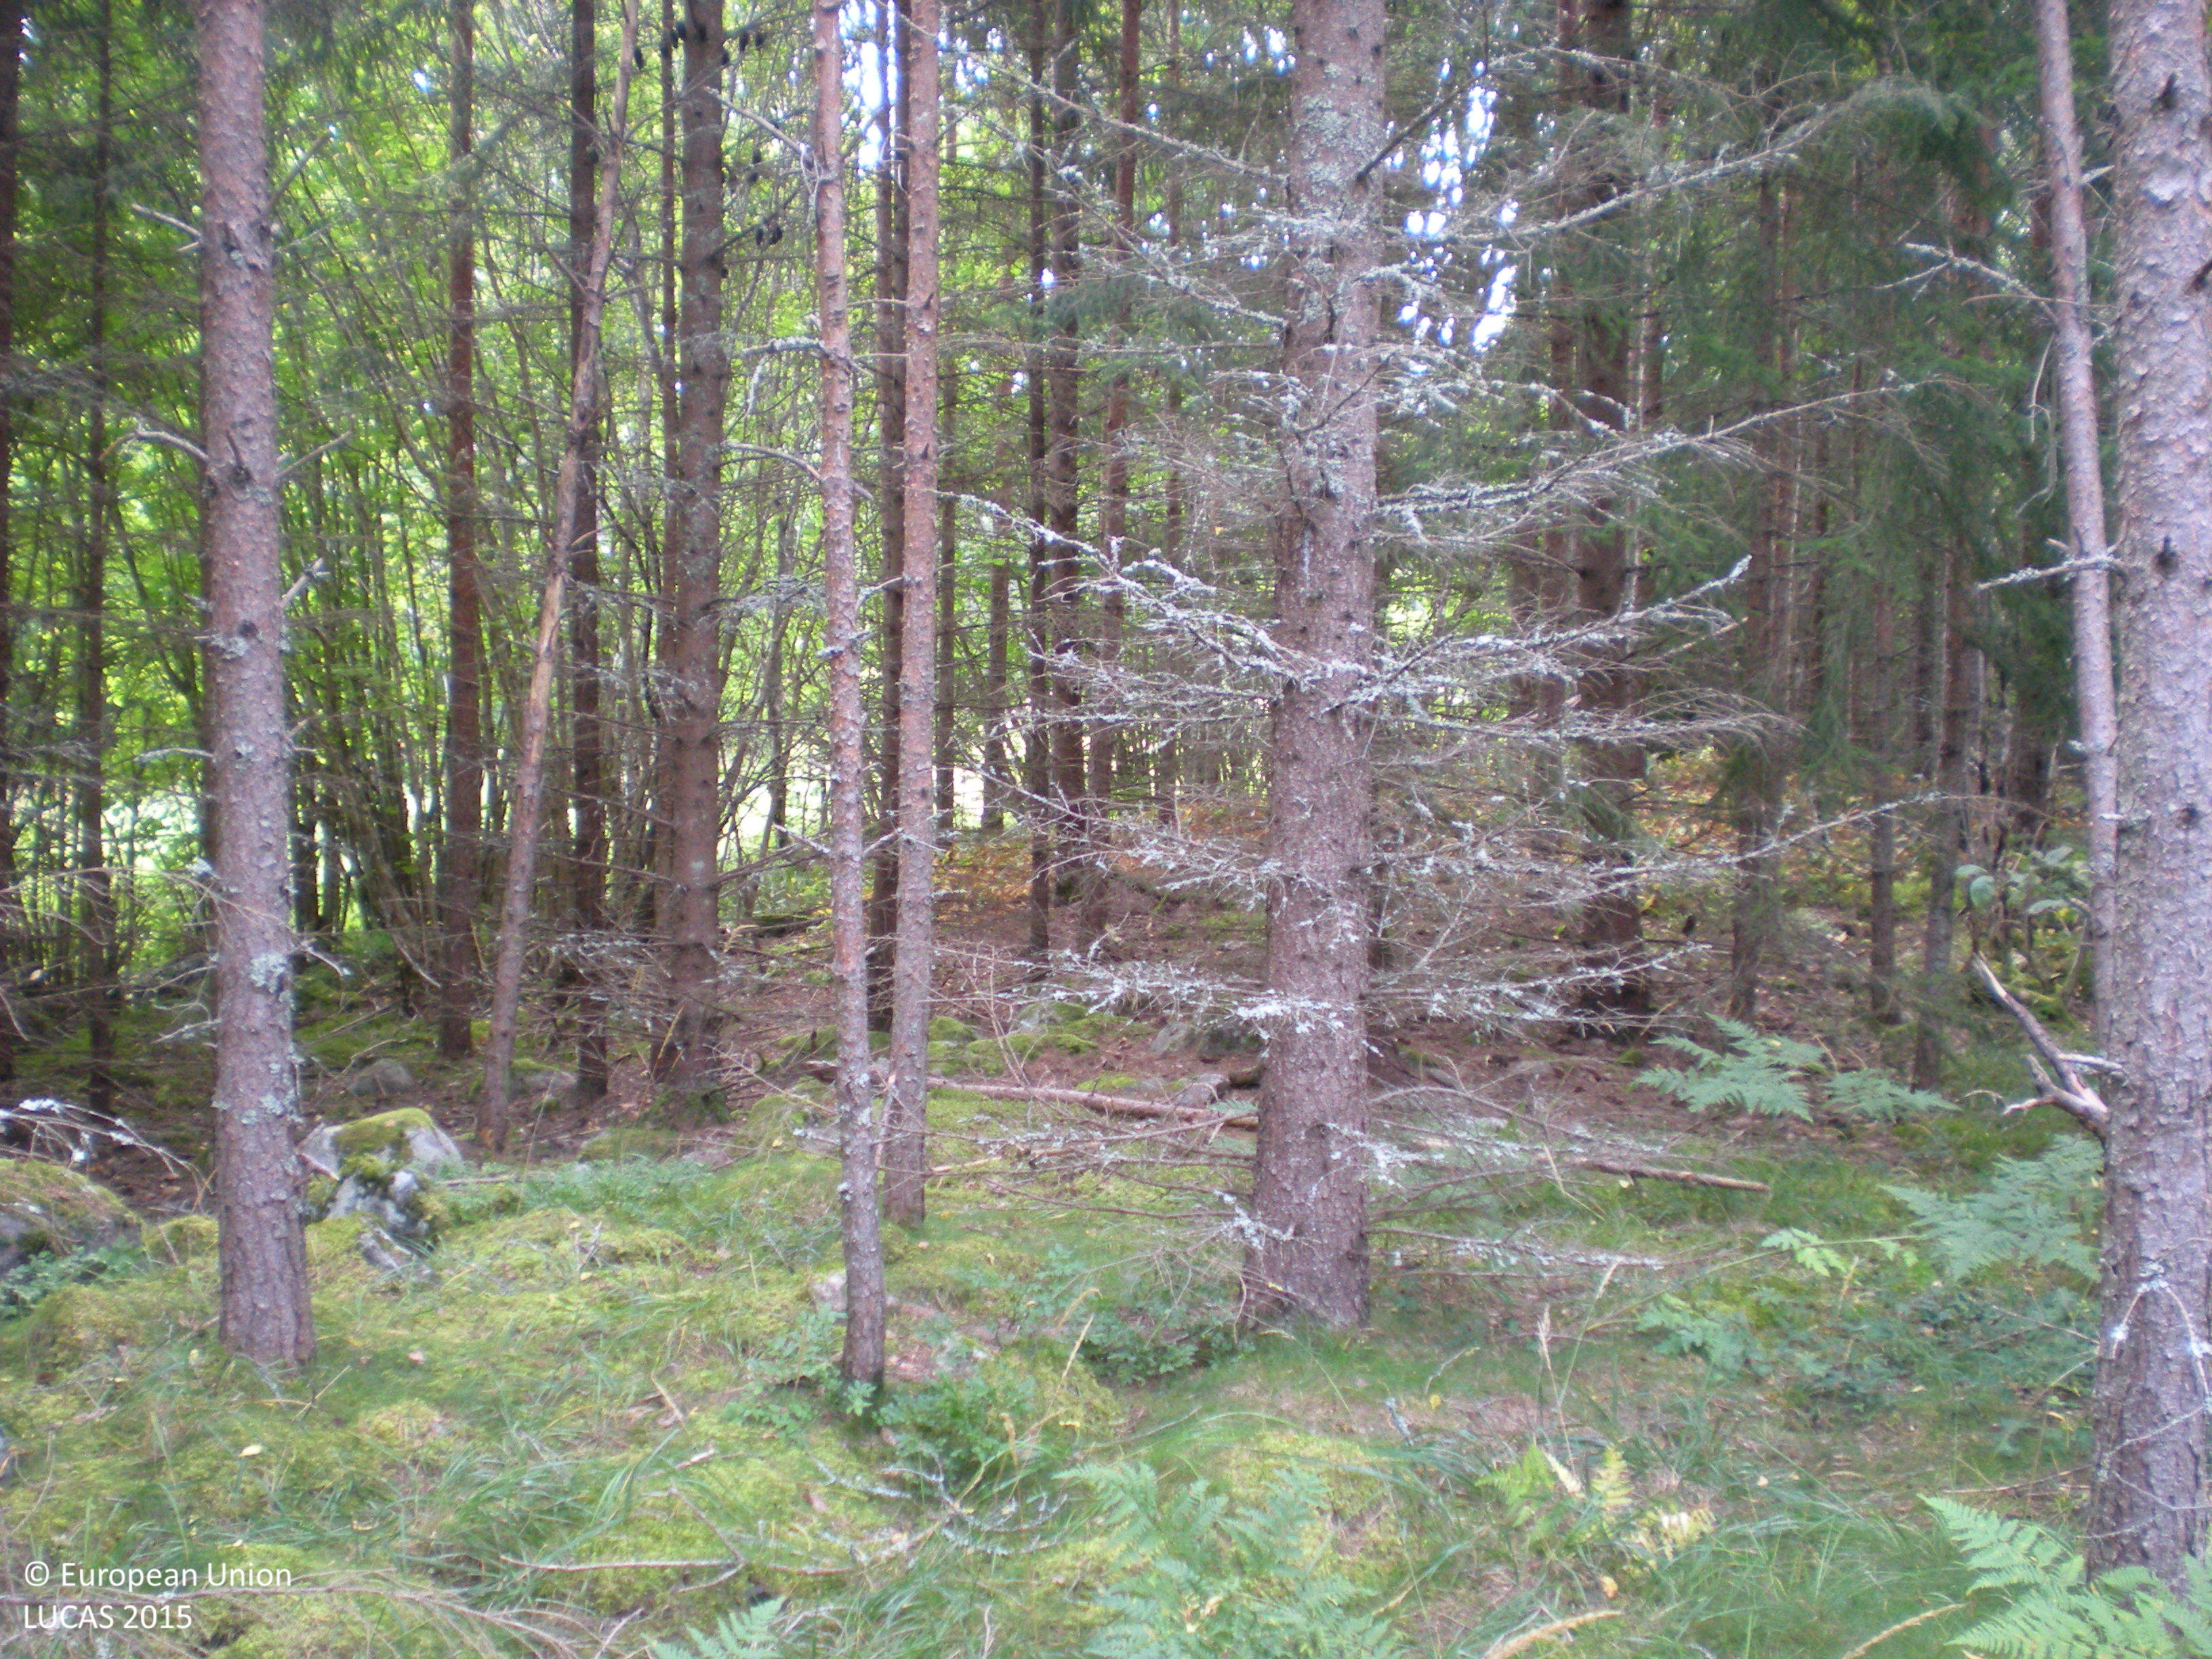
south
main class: Woodland
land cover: Other coniferous woodland
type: boreal forest
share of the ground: 50 - 75 %
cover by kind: coniferous forest trees 65 %, herbaceous plants 20 %, broadleaved forest trees 5 %, shrubs 5 %, lichens and mosses 5 %
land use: Forestry
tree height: > 5 m
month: August
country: SE
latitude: 60.4637
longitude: 17.6110
